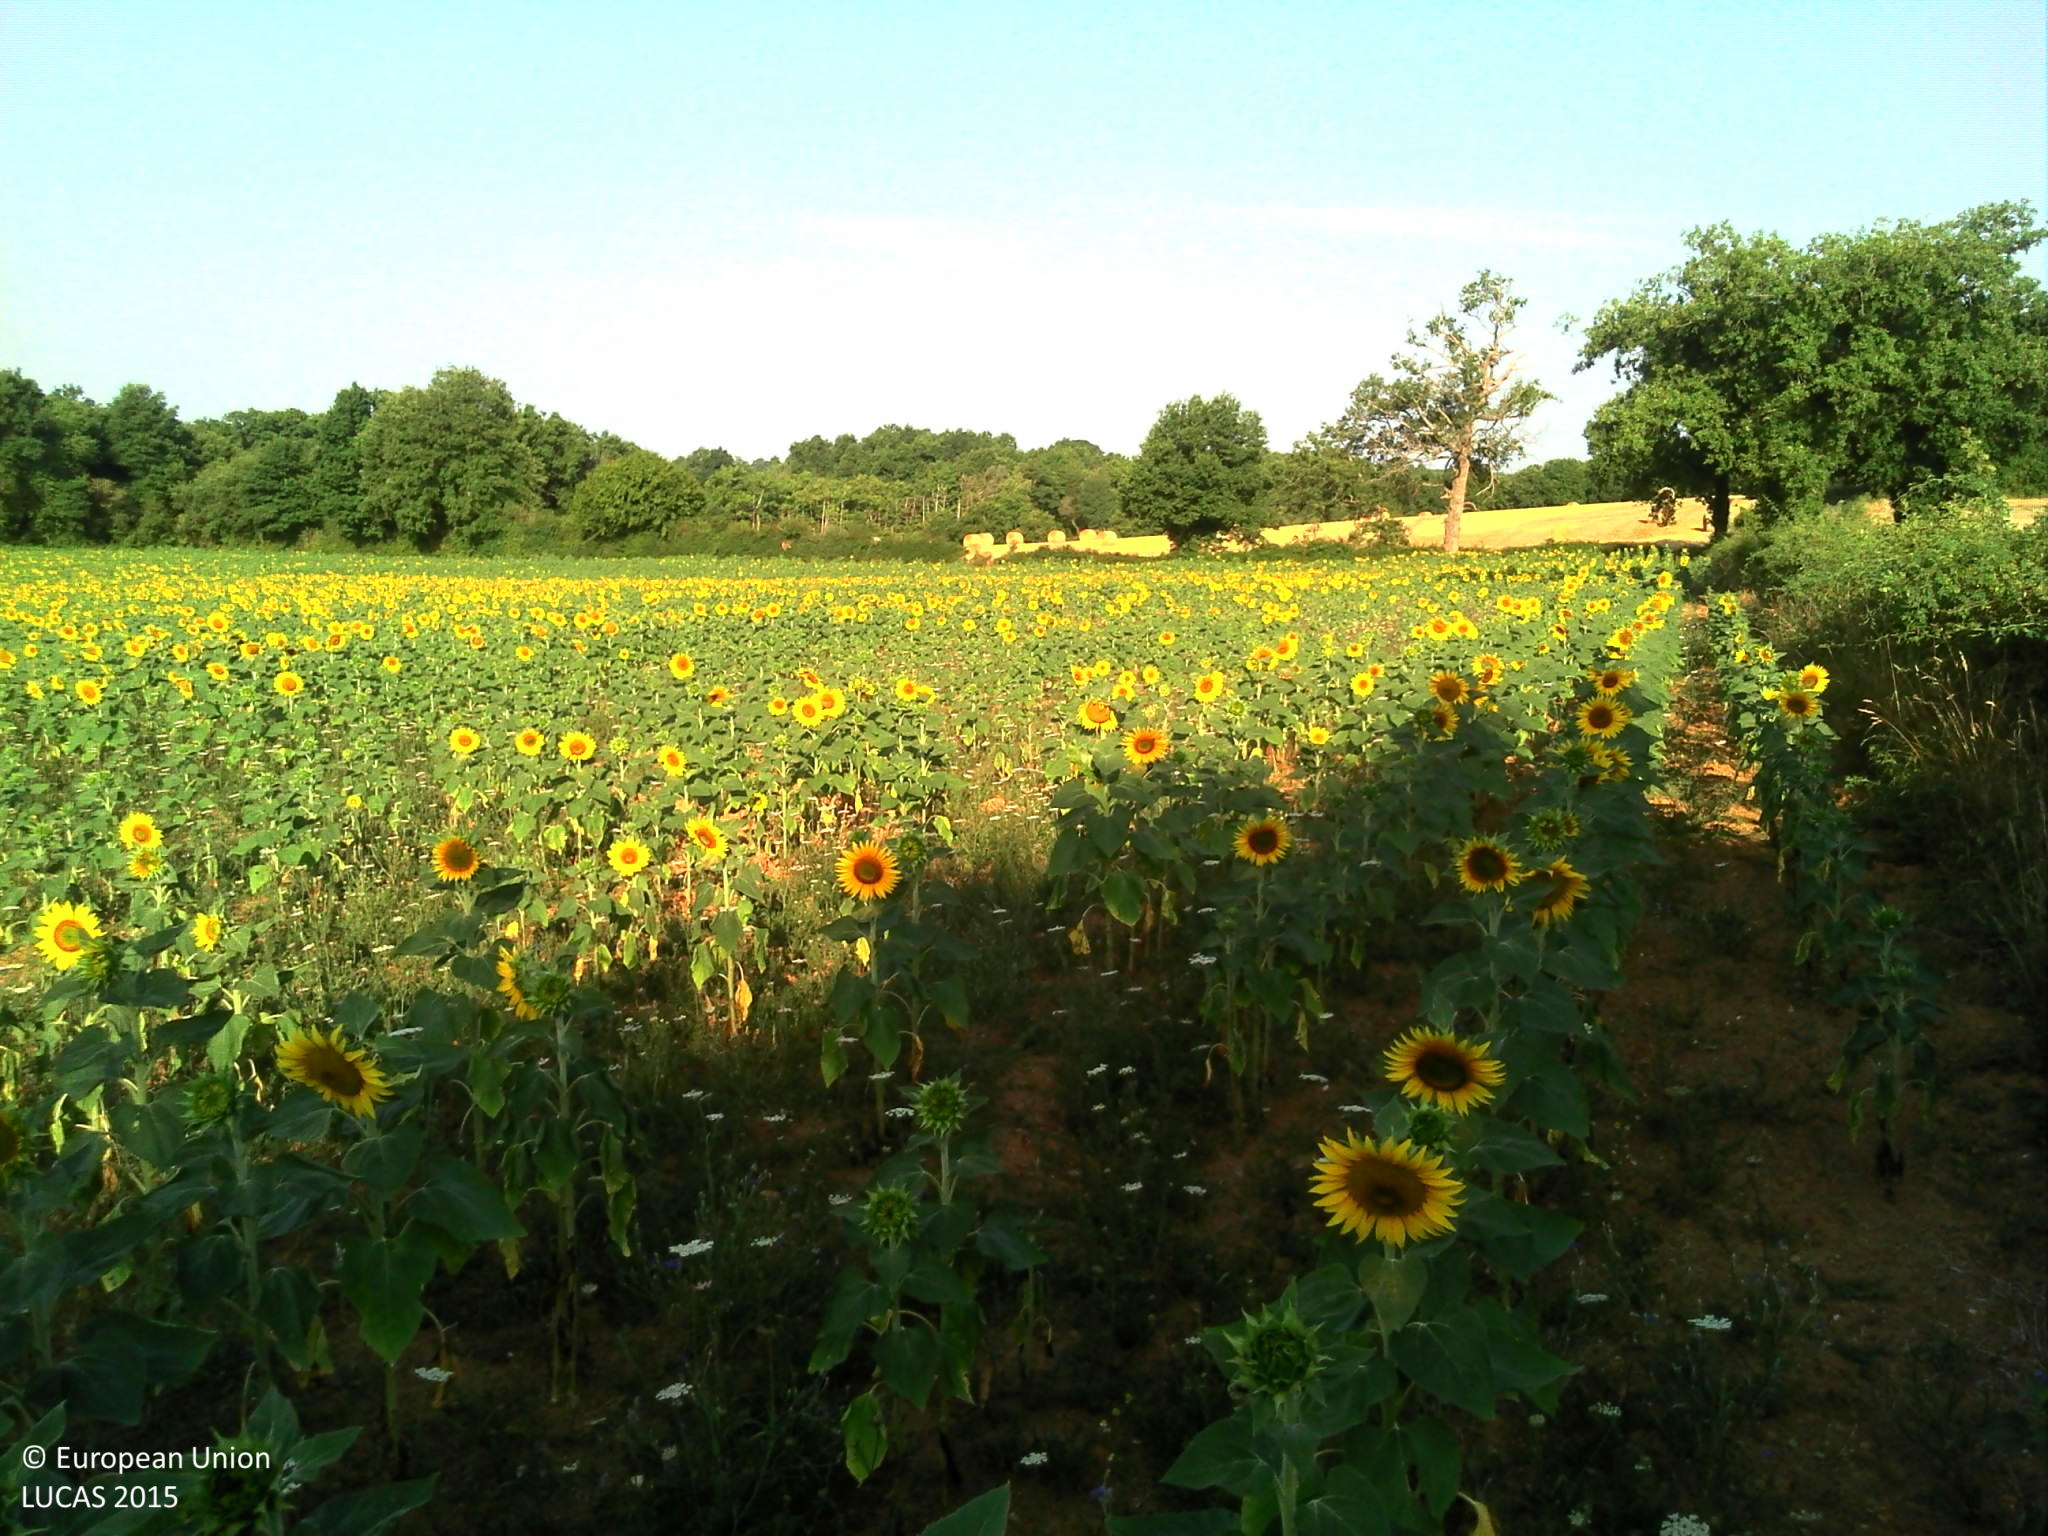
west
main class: Cropland
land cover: Sunflower
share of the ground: > 75 %
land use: Agriculture (excluding fallow land and kitchen gardens)
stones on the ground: < 10 %
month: July
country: FR
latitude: 46.3033
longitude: 0.6494
